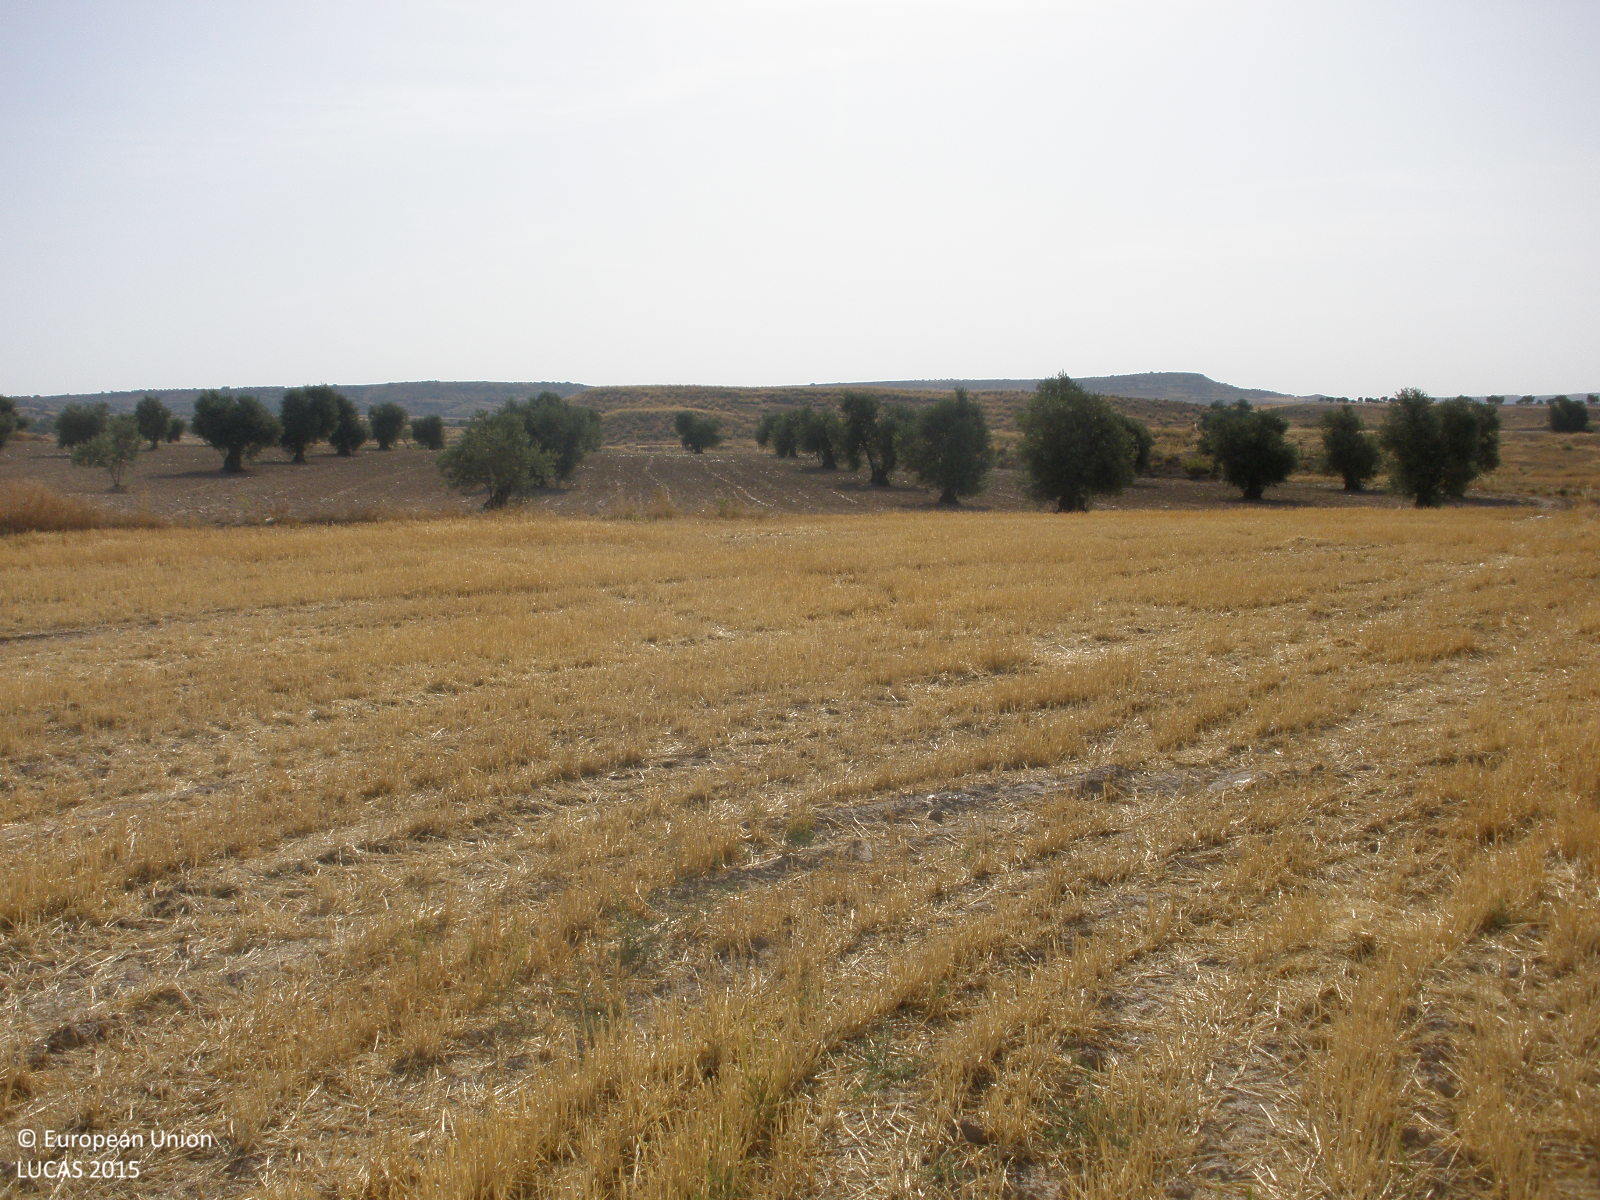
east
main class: Cropland
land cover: Barley
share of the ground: < 10 %
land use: Agriculture (excluding fallow land and kitchen gardens)
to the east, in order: Barley; Tracks; Olive groves; Shrubland without tree cover; Artificial constructions in urban areas; Shrubland without tree cover; Tracks; Other bare soil; Grass margins; Barley; Grass margins; Other bare soil; Grass margins; Tracks; Grass margins; Shrubland without tree cover
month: July
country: ES
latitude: 40.1040
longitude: -3.4624
